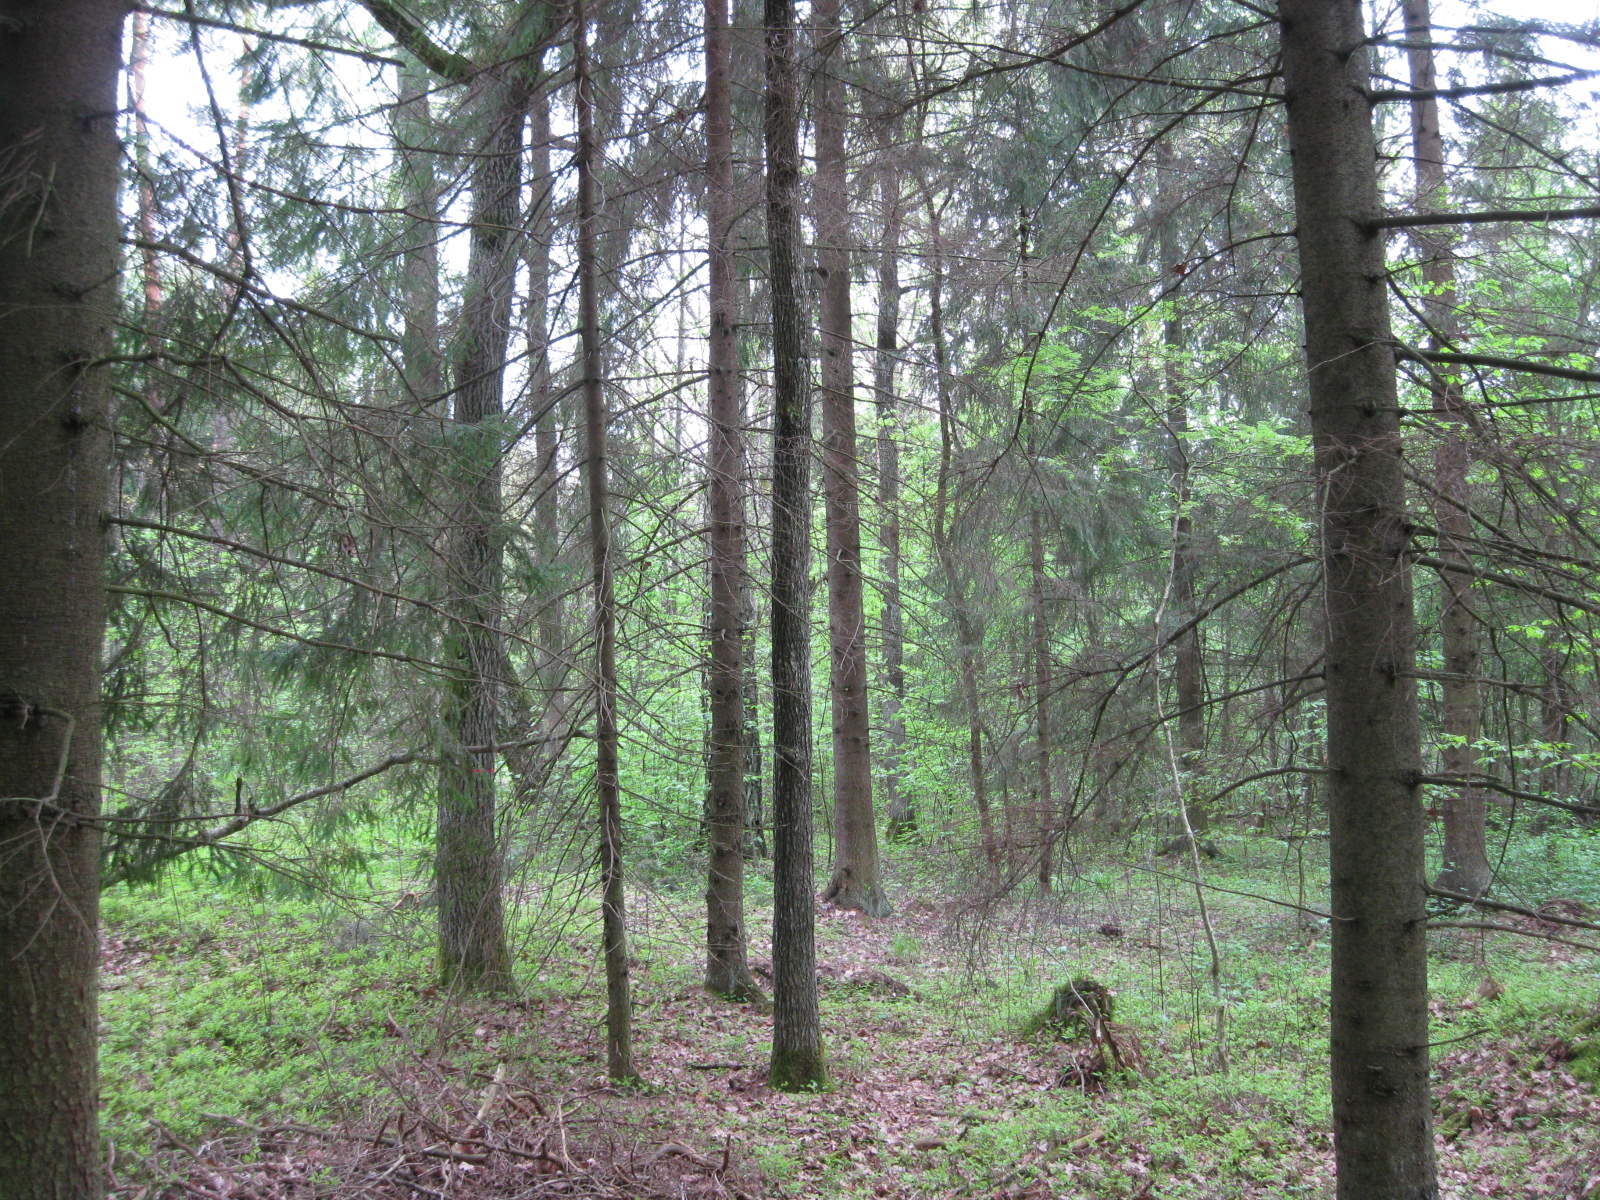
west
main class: Woodland
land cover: Other mixed woodland
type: hemiboreal forest and nemoral coniferous forest and mixed broadleaved-coniferous forest
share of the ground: > 75 %
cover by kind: coniferous forest trees 45 %, broadleaved forest trees 40 %, shrubs 5 %, herbaceous plants 5 %, lichens and mosses 5 %
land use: Forestry
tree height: > 5 m
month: May
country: LT
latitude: 55.9588
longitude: 24.3671
